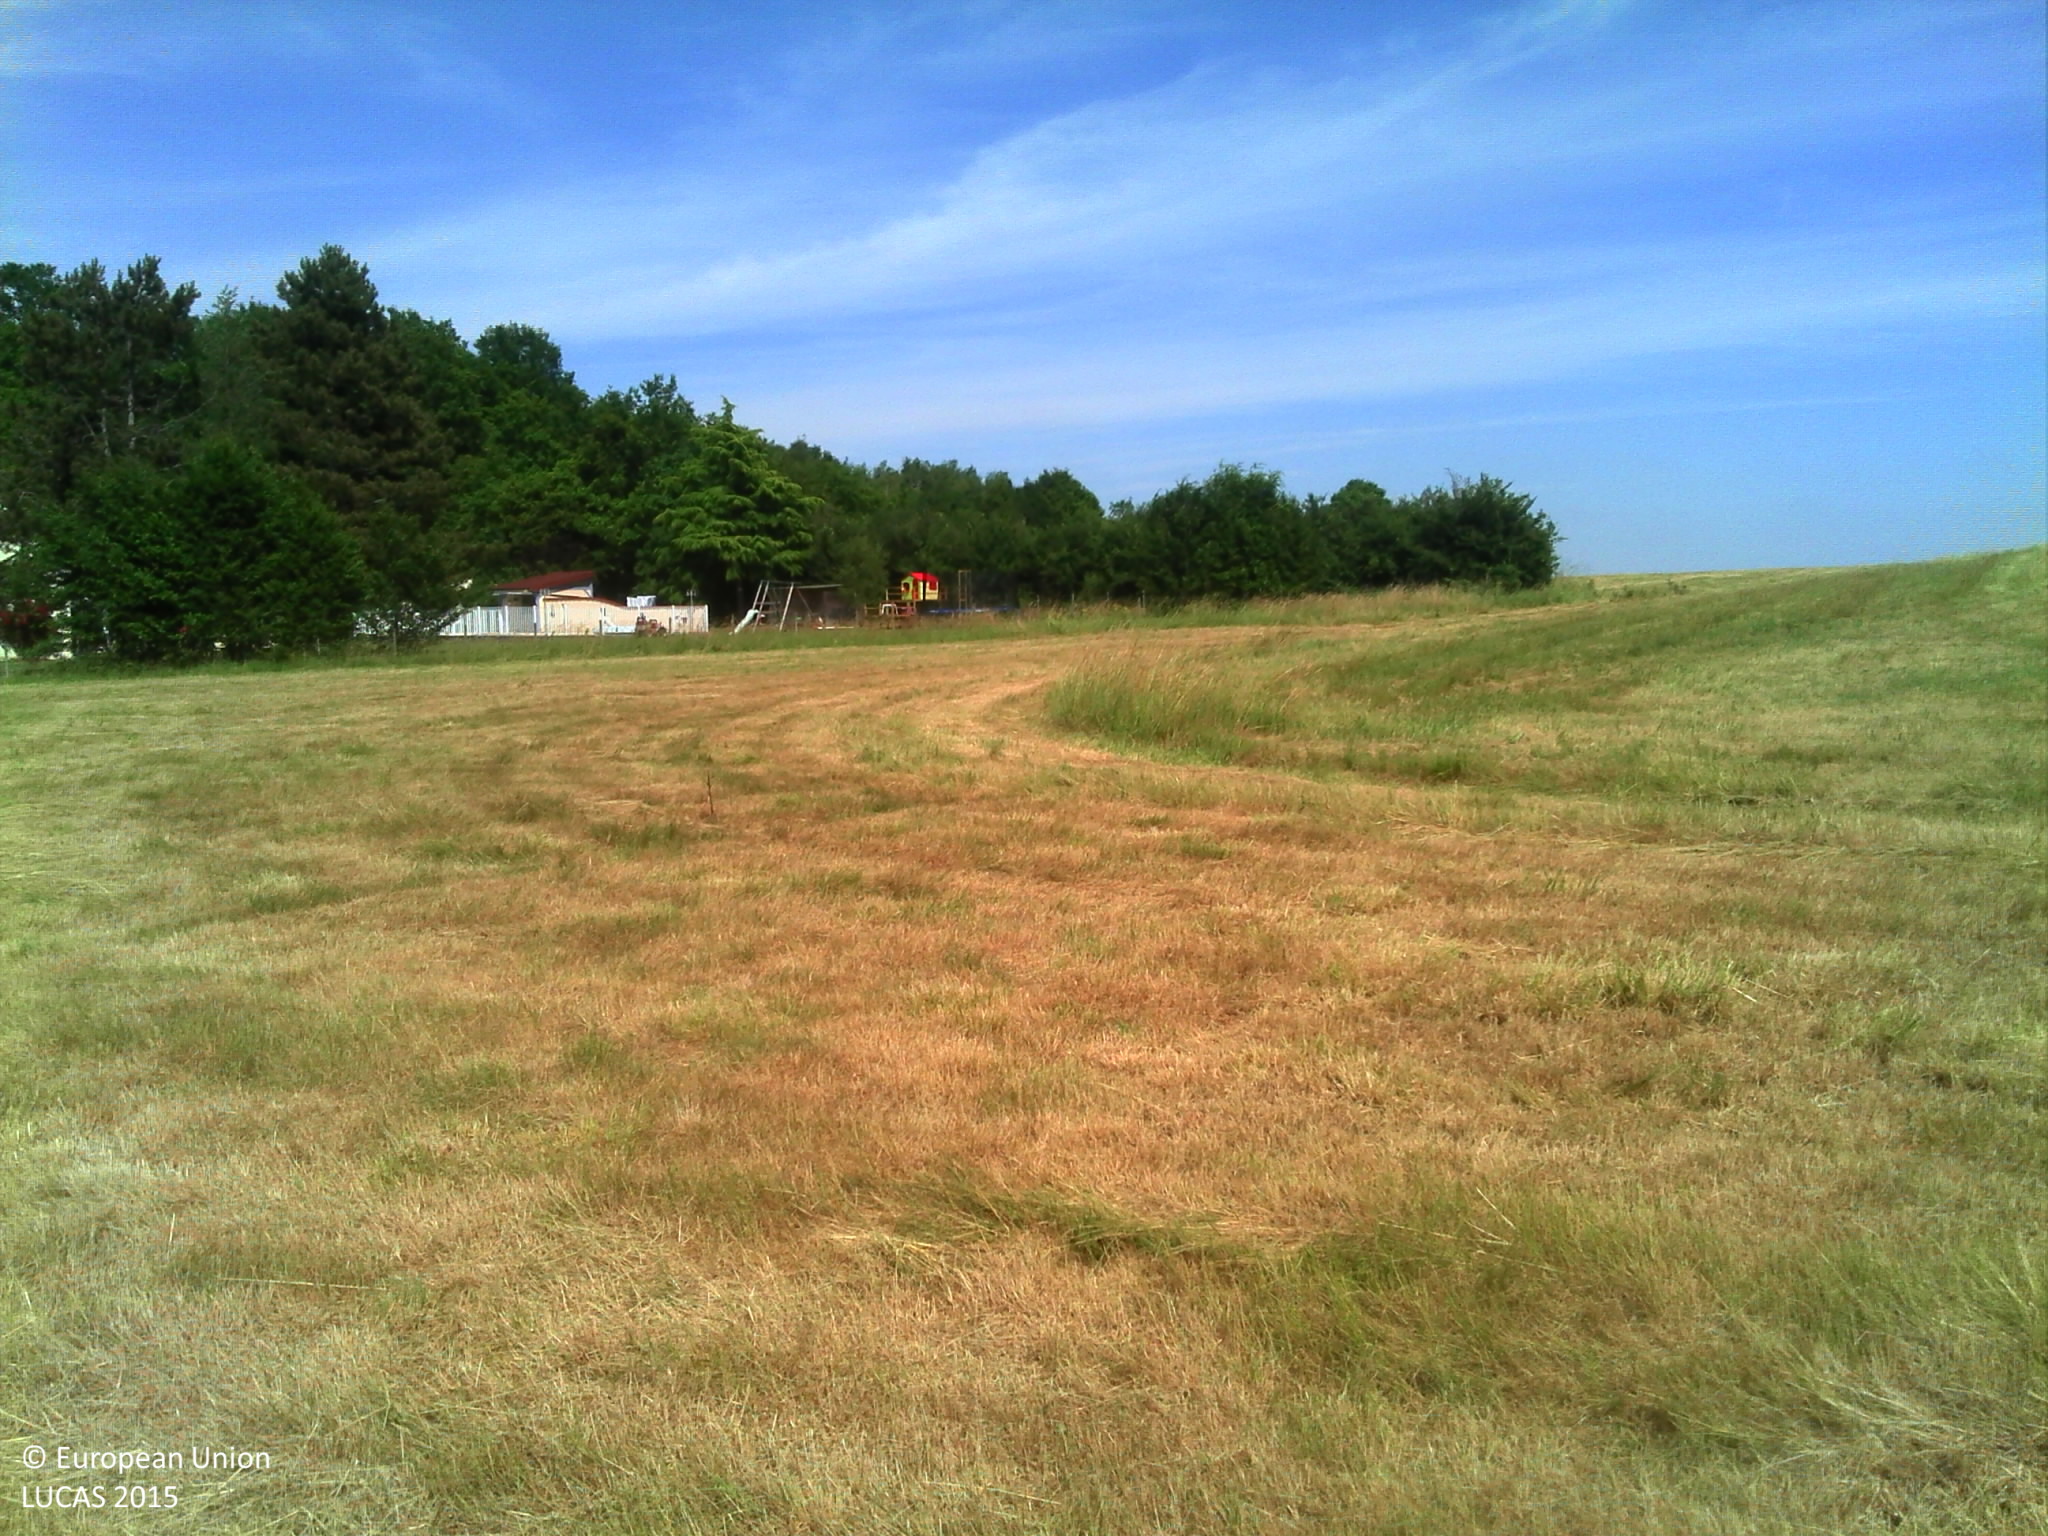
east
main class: Grassland
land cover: Grassland without tree/shrub cover
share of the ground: > 75 %
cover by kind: herbaceous plants 100 %
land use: Air transport
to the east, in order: Grassland without tree/shrub cover; Managed hedges; Grassland without tree/shrub cover; Managed hedges; Ditches and canals; Grass margins; Paved roads, cycling and walking lanes; Ditches and canals; Fences; Grassland without tree/shrub cover
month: June
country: FR
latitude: 47.3629
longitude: 2.9104
